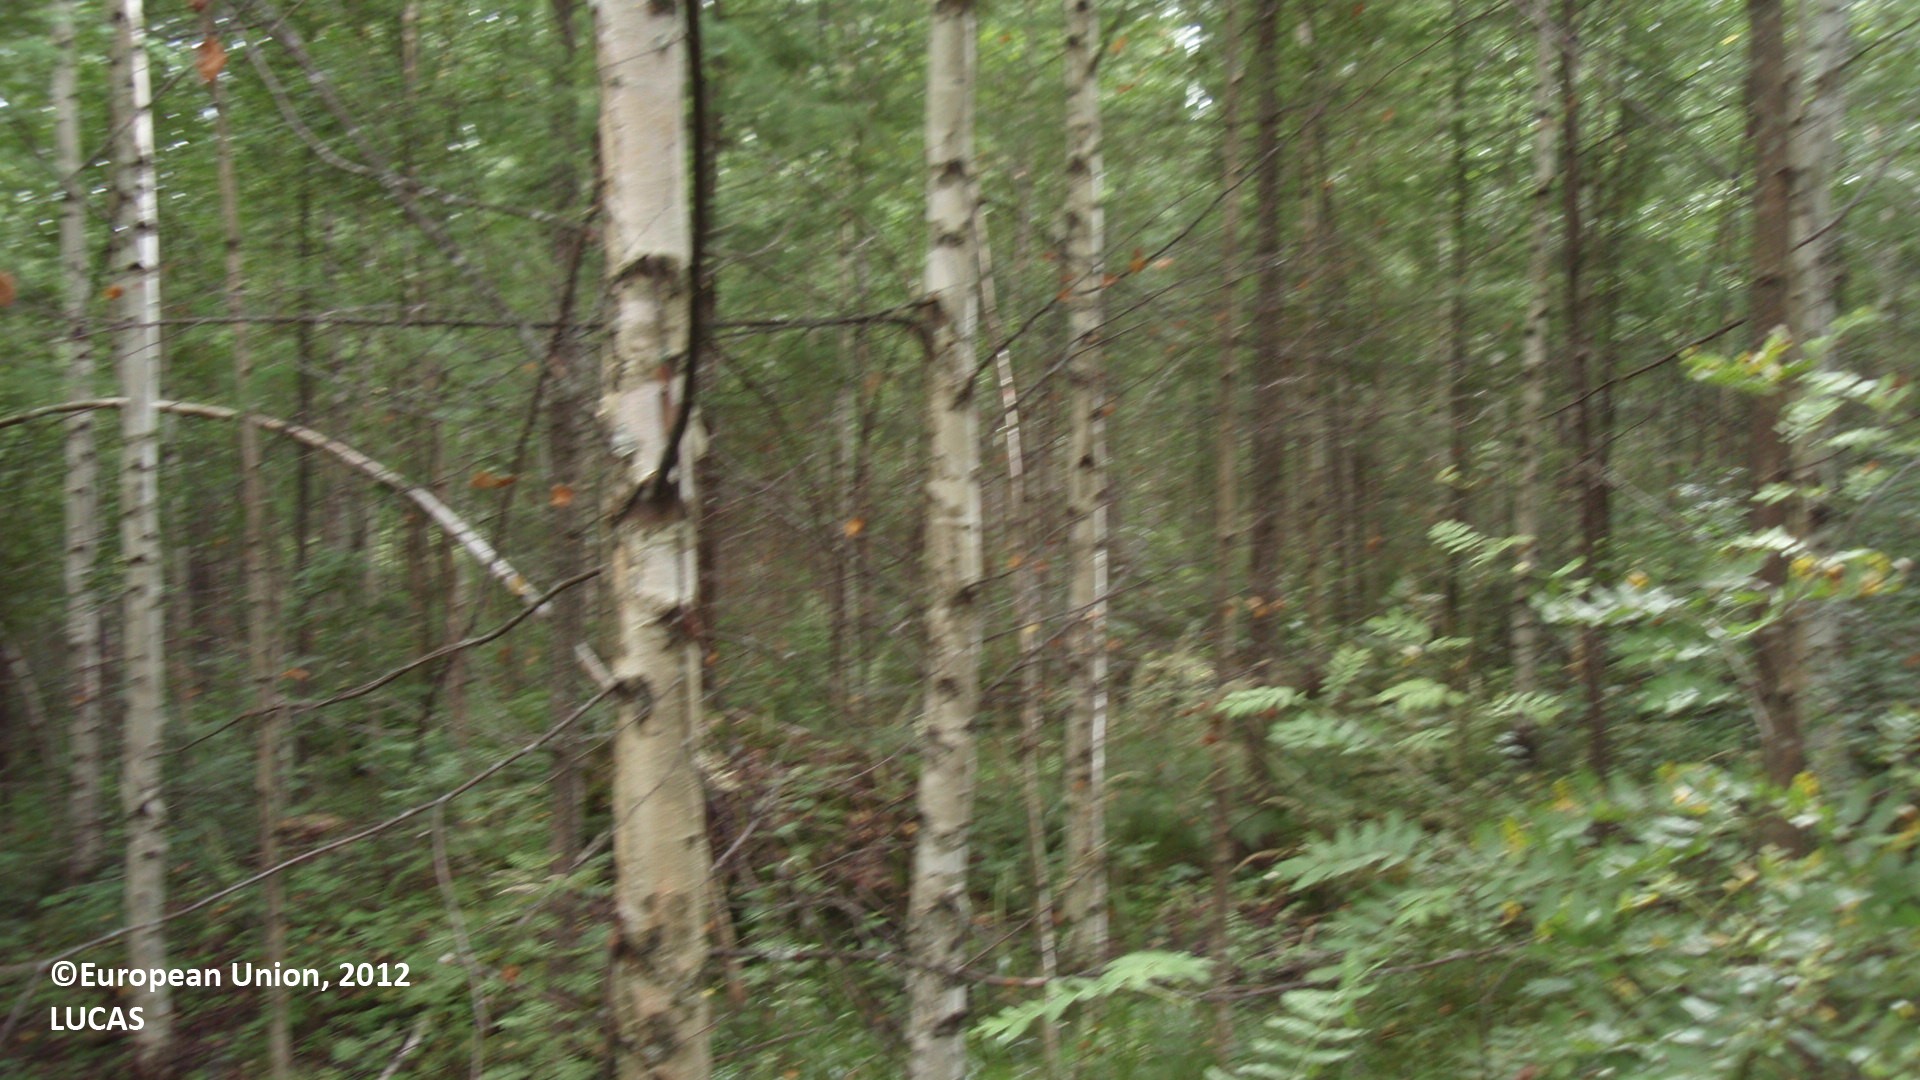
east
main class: Woodland
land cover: Broadleaved woodland
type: non-riverine alder, birch or aspen forest
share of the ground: 50 - 75 %
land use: Forestry
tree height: > 5 m
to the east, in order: Broadleaved woodland; Fences; Grassland without tree/shrub cover; Fences; Spruce dominated mixed woodland; Pine dominated coniferous woodland
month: August
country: FI
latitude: 60.9200
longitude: 26.9312
